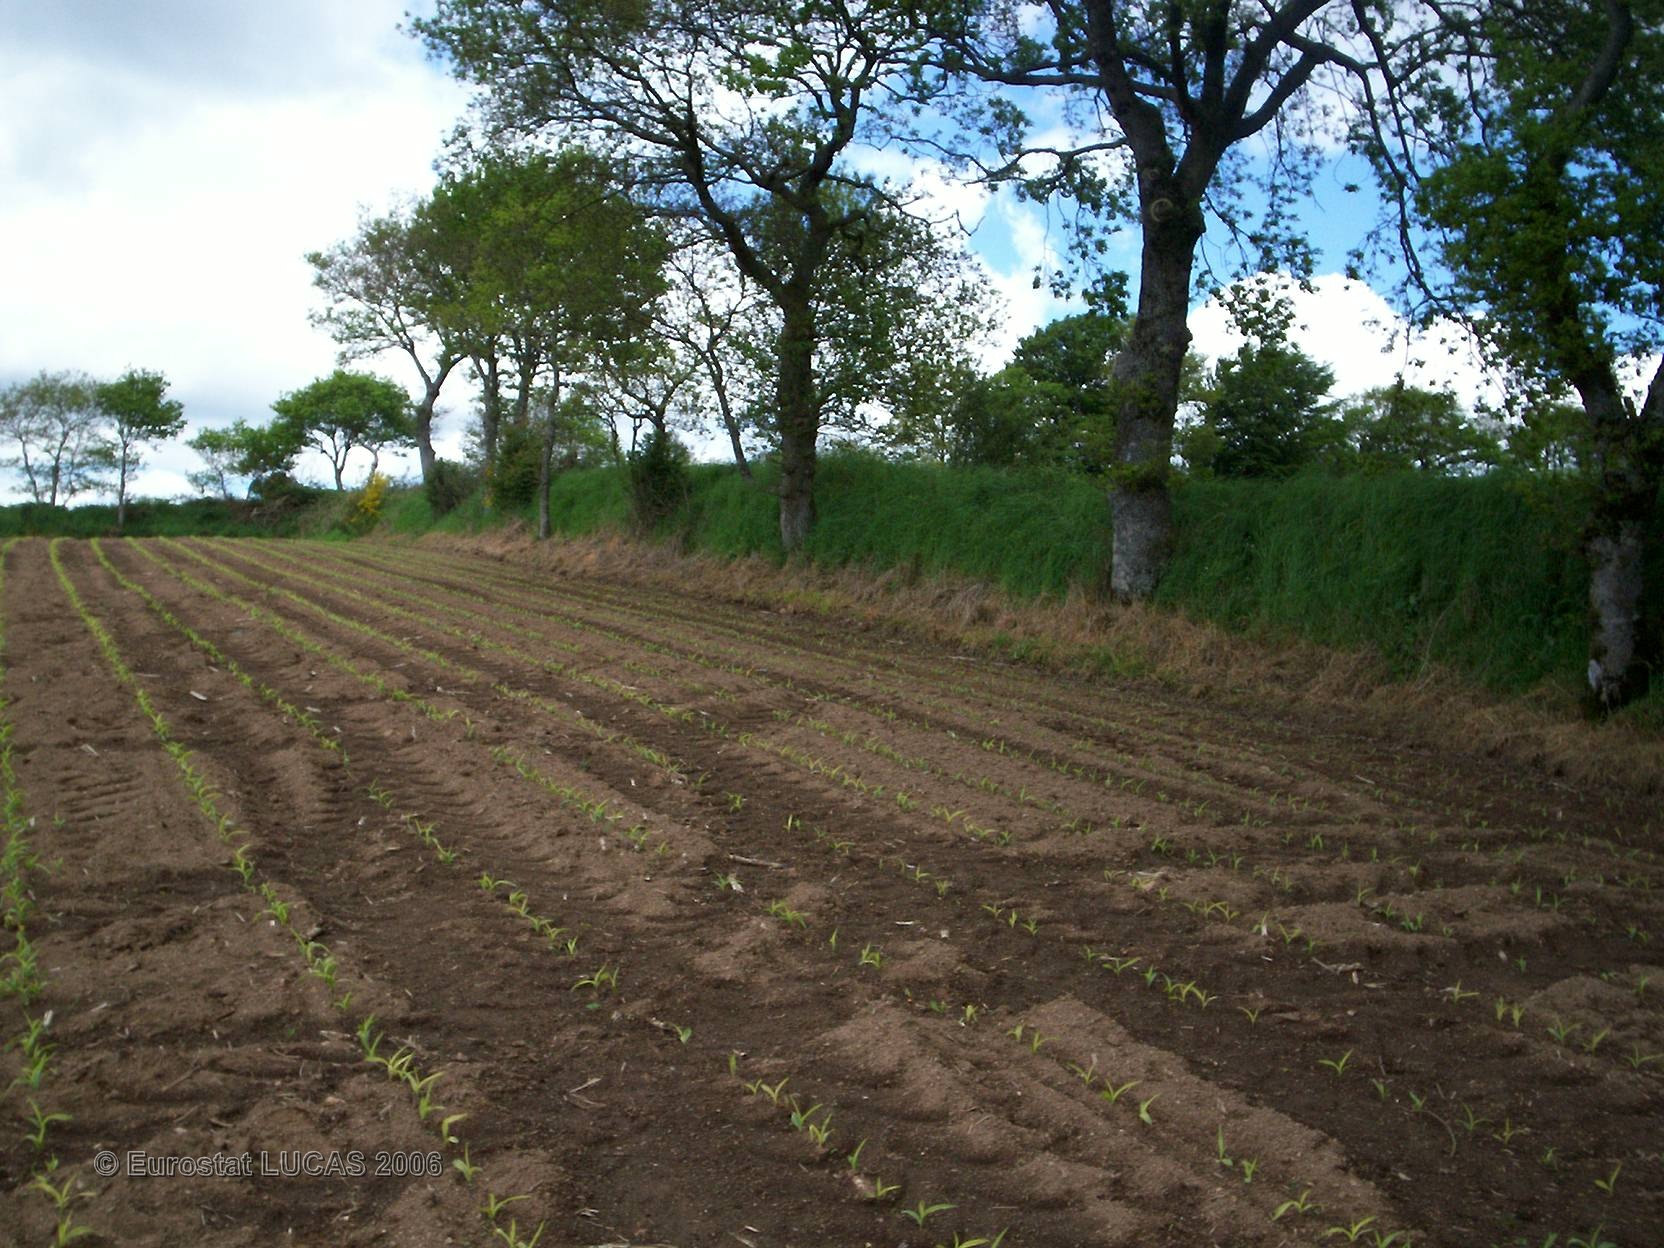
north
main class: Cropland
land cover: Maize
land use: Agriculture (excluding fallow land and kitchen gardens)
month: May
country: FR
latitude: 48.3948
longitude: -3.0220
